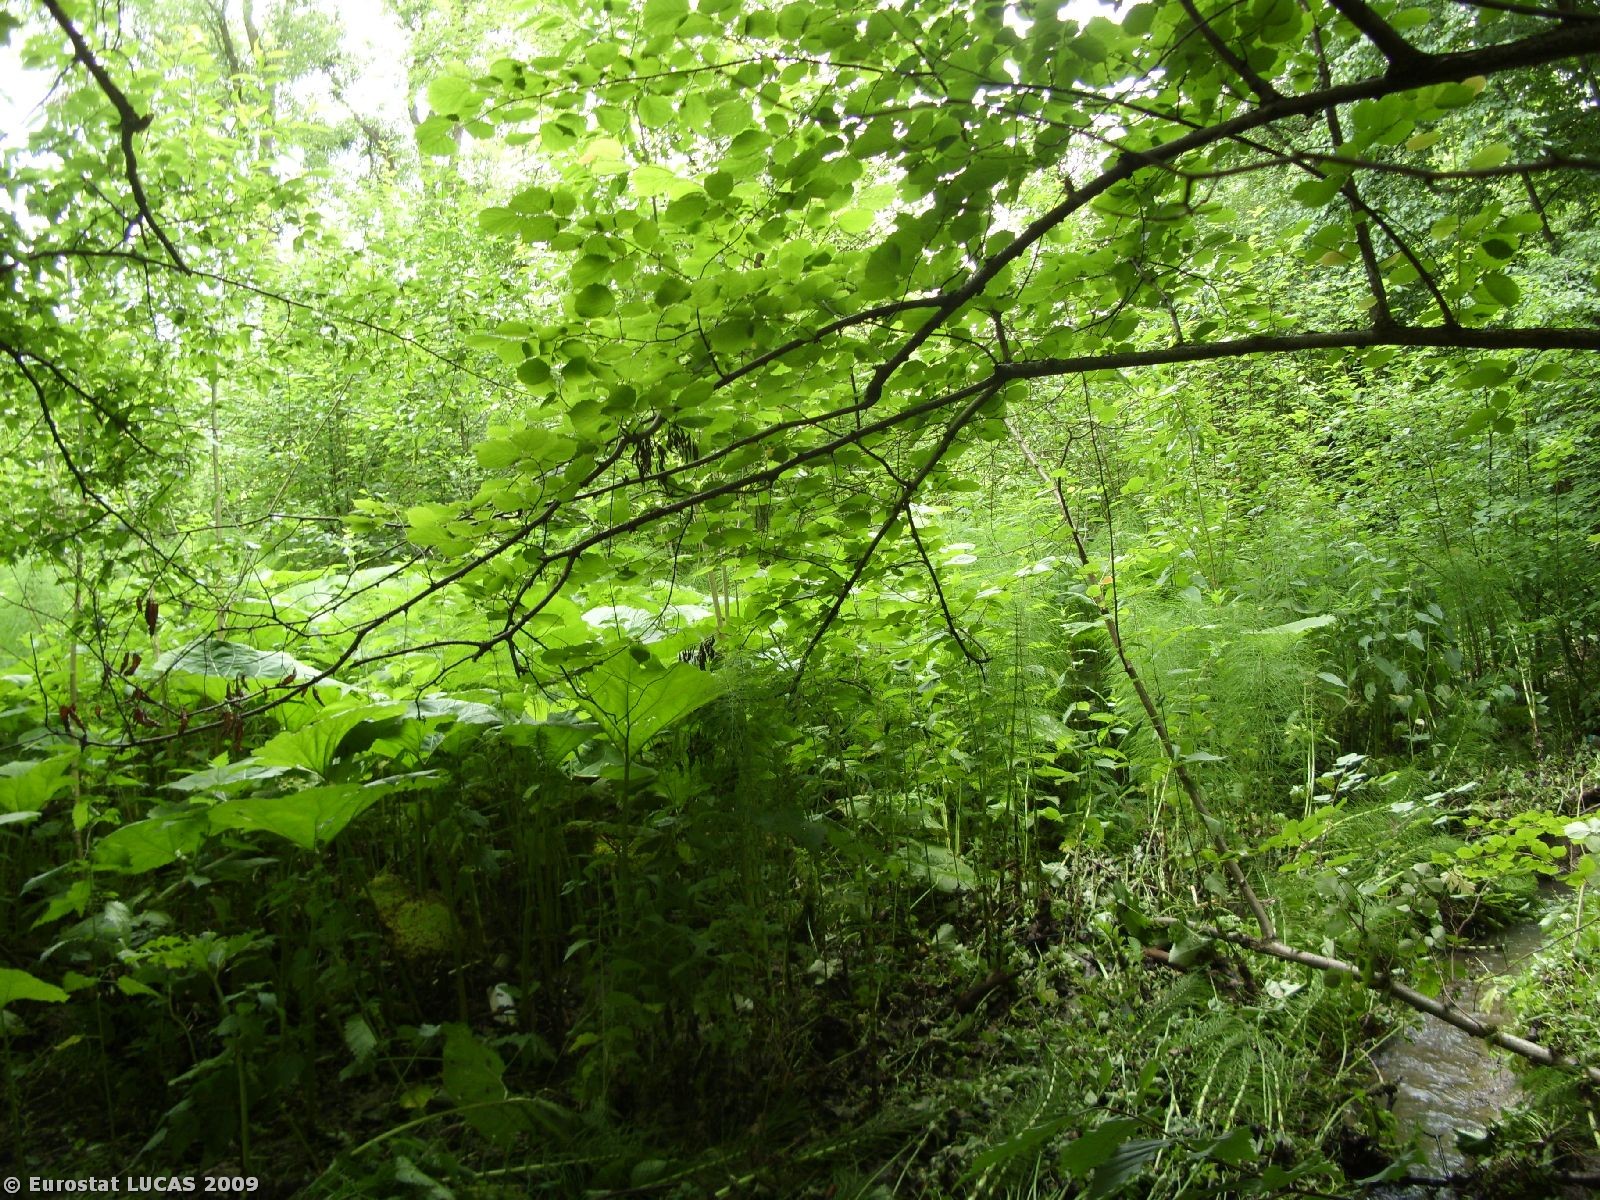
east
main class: Woodland
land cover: Broadleaved woodland
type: mesophytic deciduous forest
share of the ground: > 75 %
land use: Unused
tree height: > 5 m
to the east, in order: Broadleaved woodland; Rivers and streams; Broadleaved woodland; Grassland without tree/shrub cover; Ditches and canals; Grassland without tree/shrub cover
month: June
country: PL
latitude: 49.8371
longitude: 20.1698
